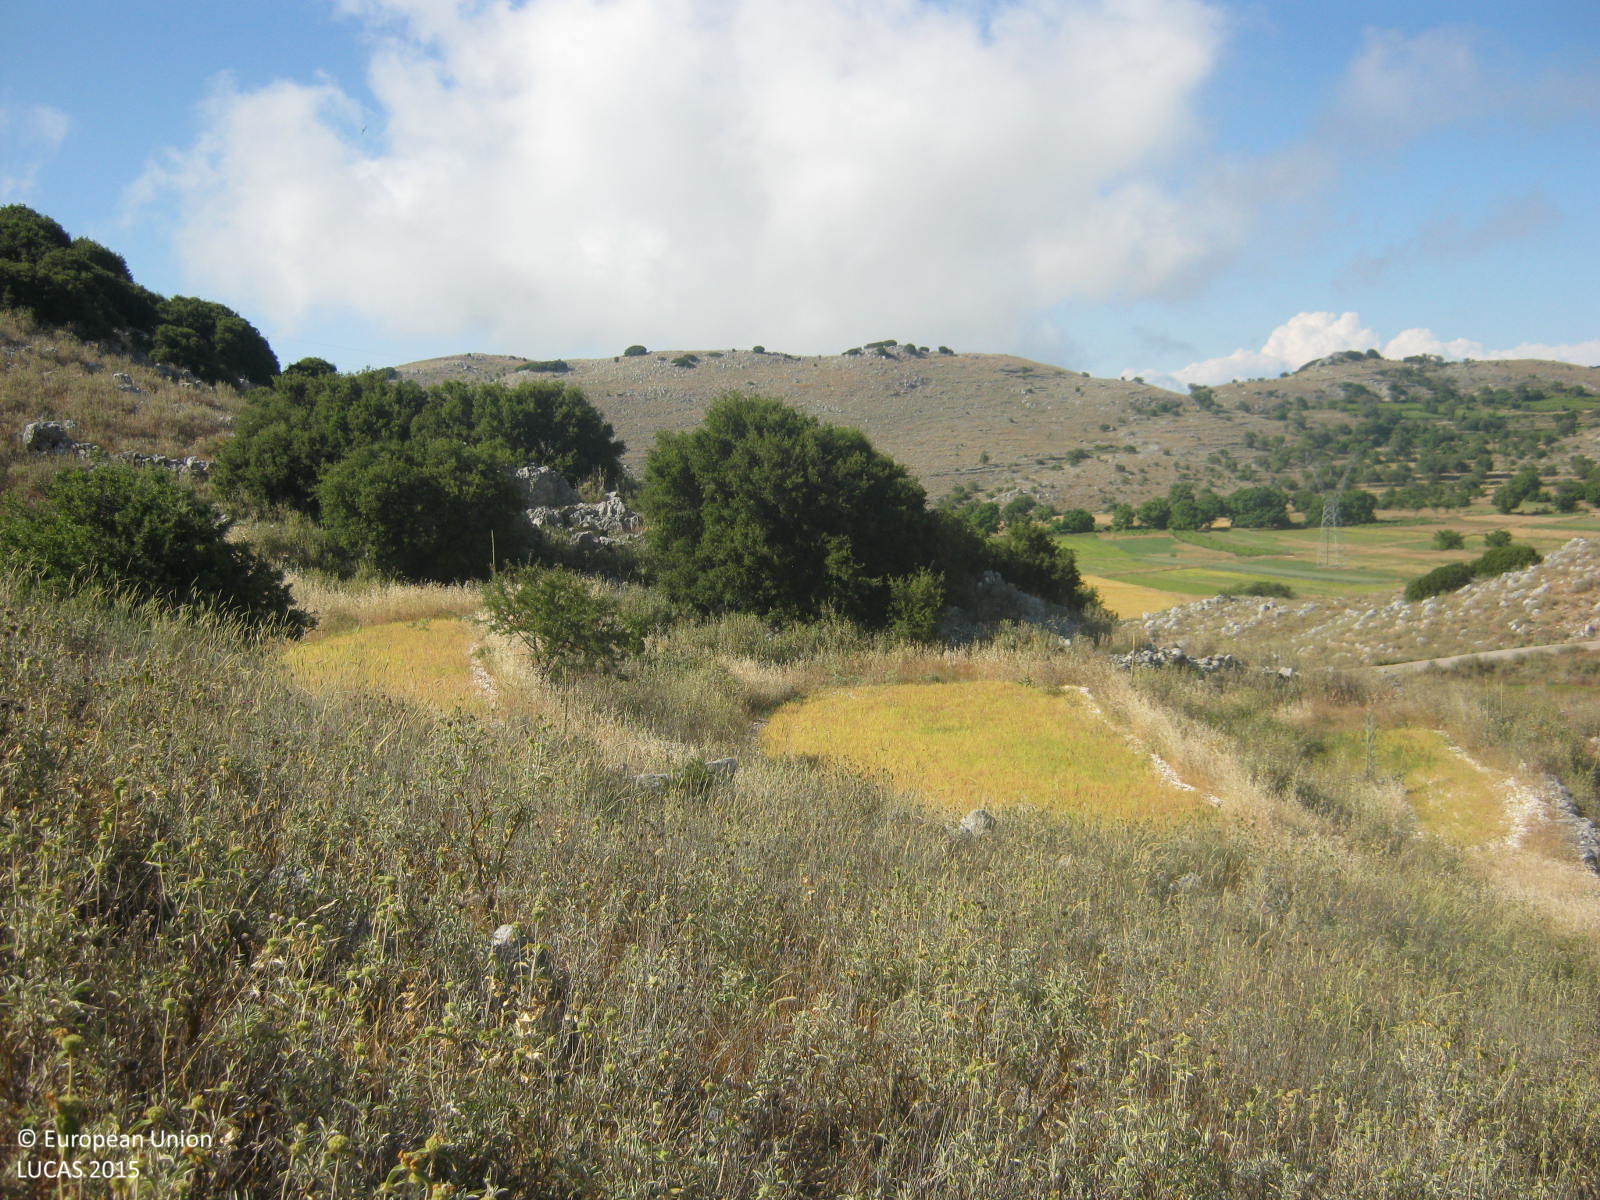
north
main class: Shrubland
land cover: Shrubland without tree cover
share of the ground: 25 - 50 %
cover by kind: shrubs 50 %, herbaceous plants 25 %, consolidated bare surface 25 %
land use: Semi-natural and natural areas not in use
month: June
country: GR
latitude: 38.7212
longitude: 20.6293
